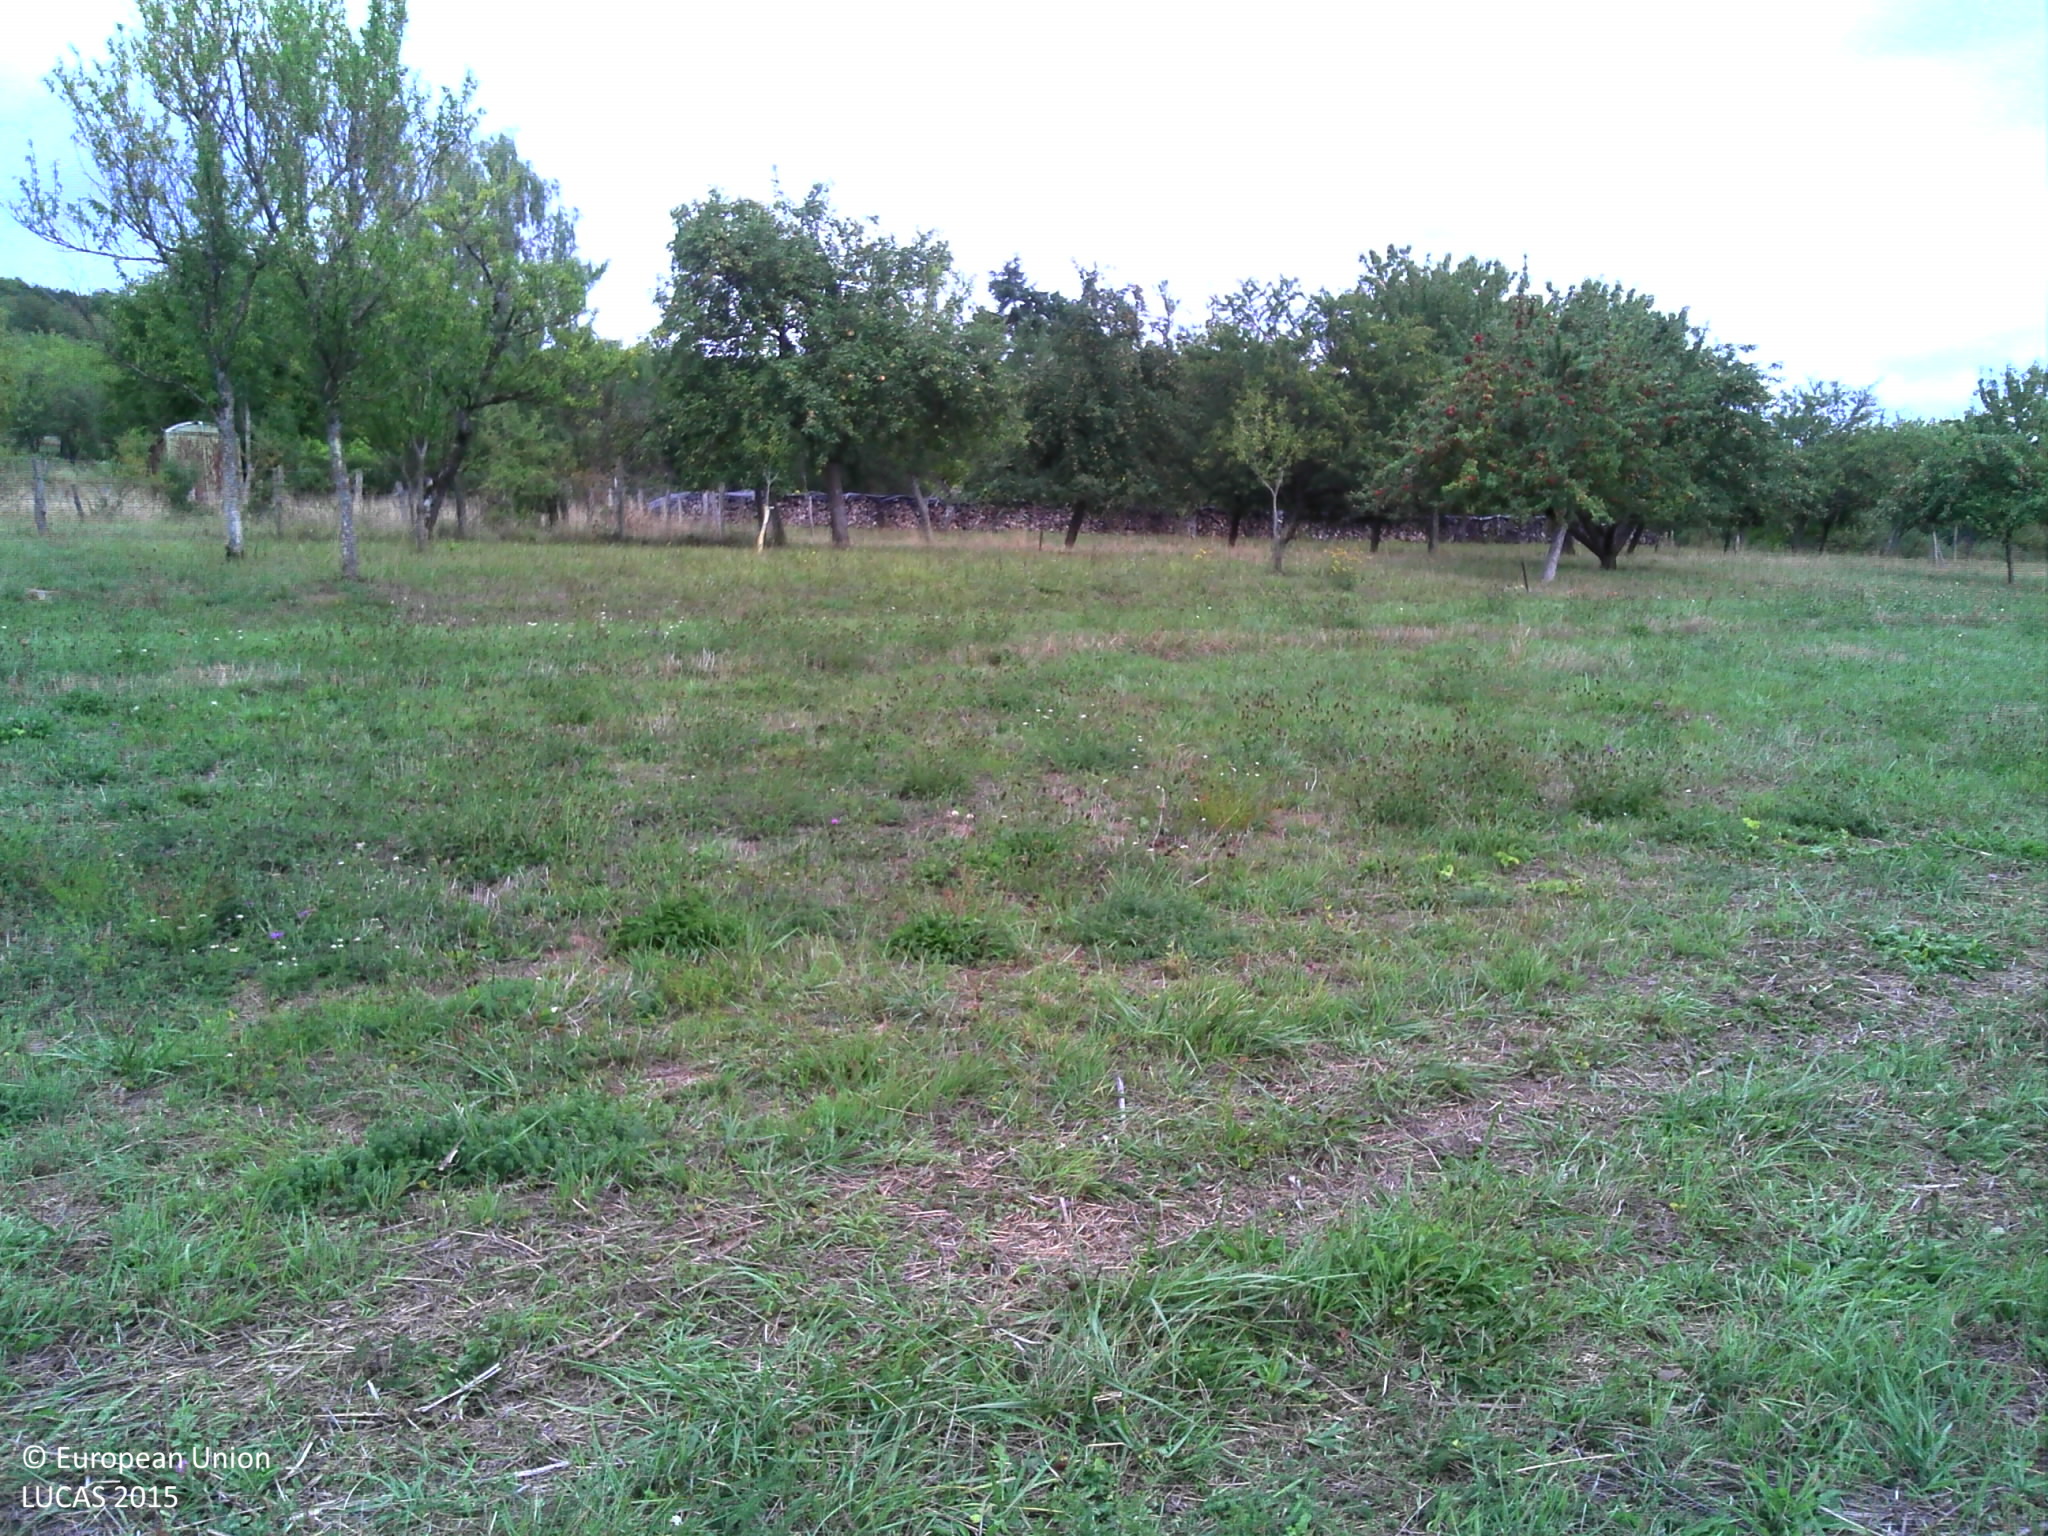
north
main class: Cropland
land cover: Temporary grasslands
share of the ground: > 75 %
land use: Agriculture (excluding fallow land and kitchen gardens)
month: September
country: FR
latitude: 48.5853
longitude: 6.0550
